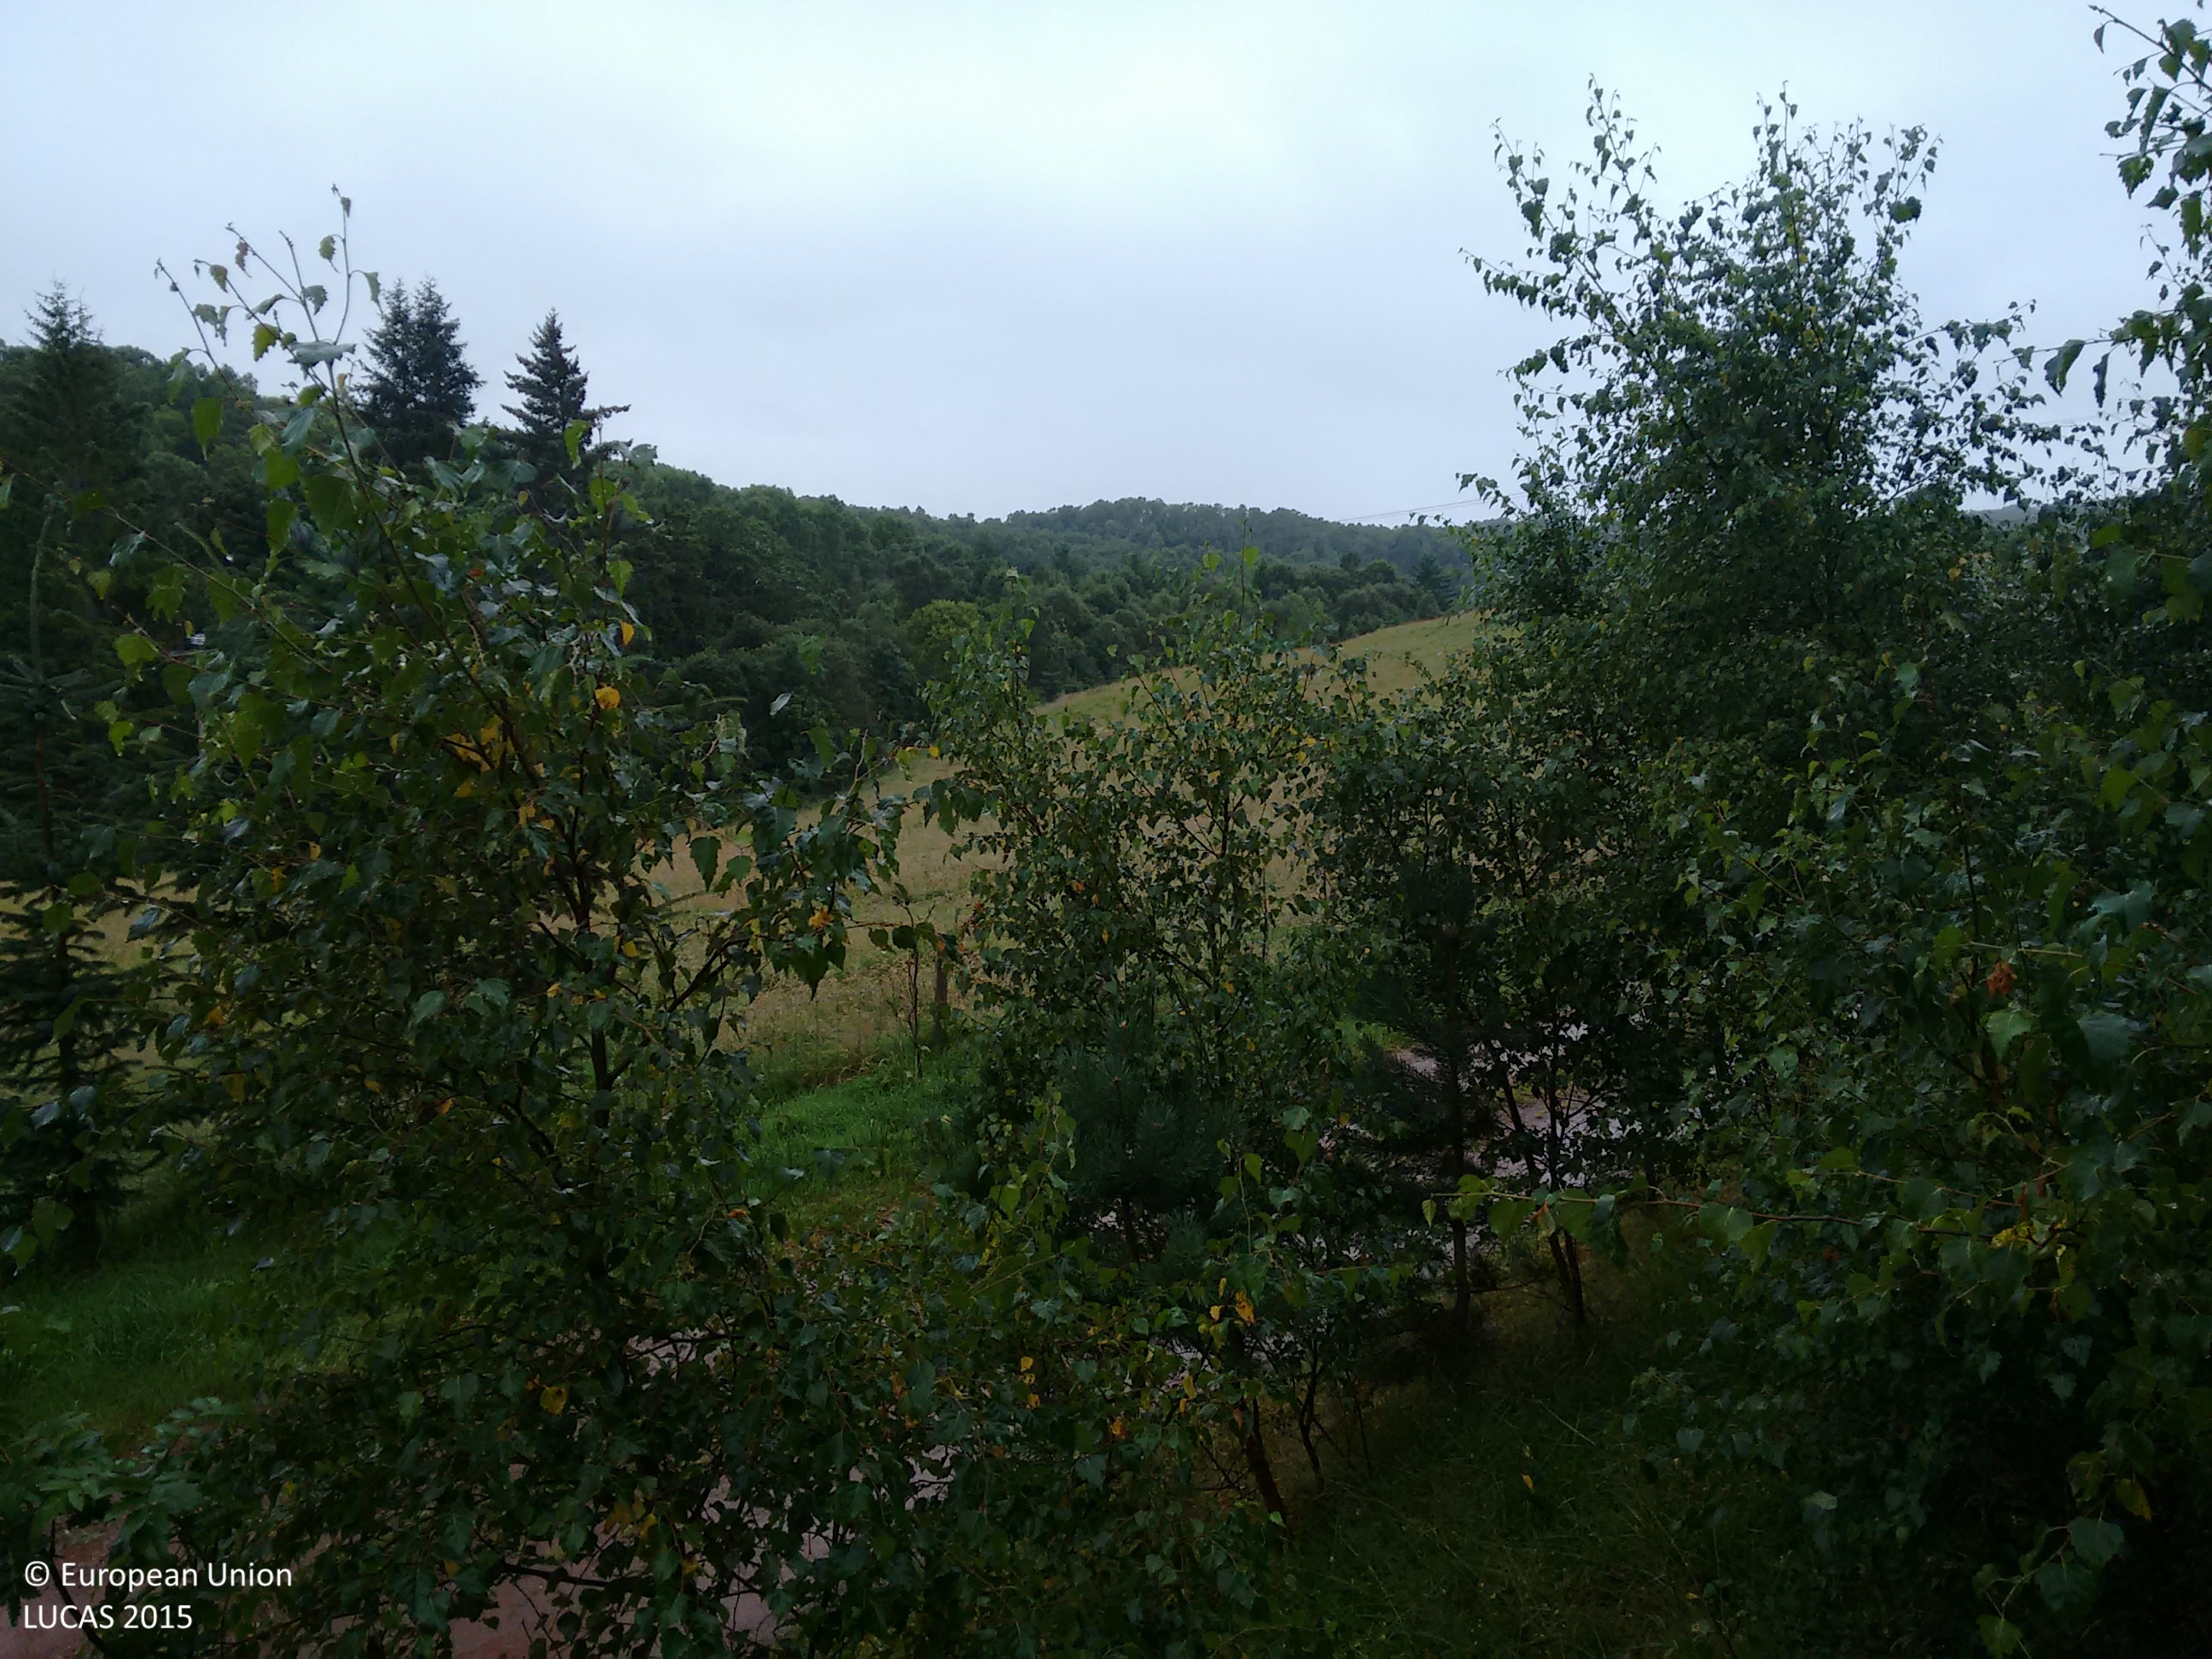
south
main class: Woodland
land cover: Broadleaved woodland
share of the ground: > 75 %
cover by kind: broadleaved forest trees 70 %, herbaceous plants 30 %
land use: Residential
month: August
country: GB
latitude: 57.2798
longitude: -4.5068
